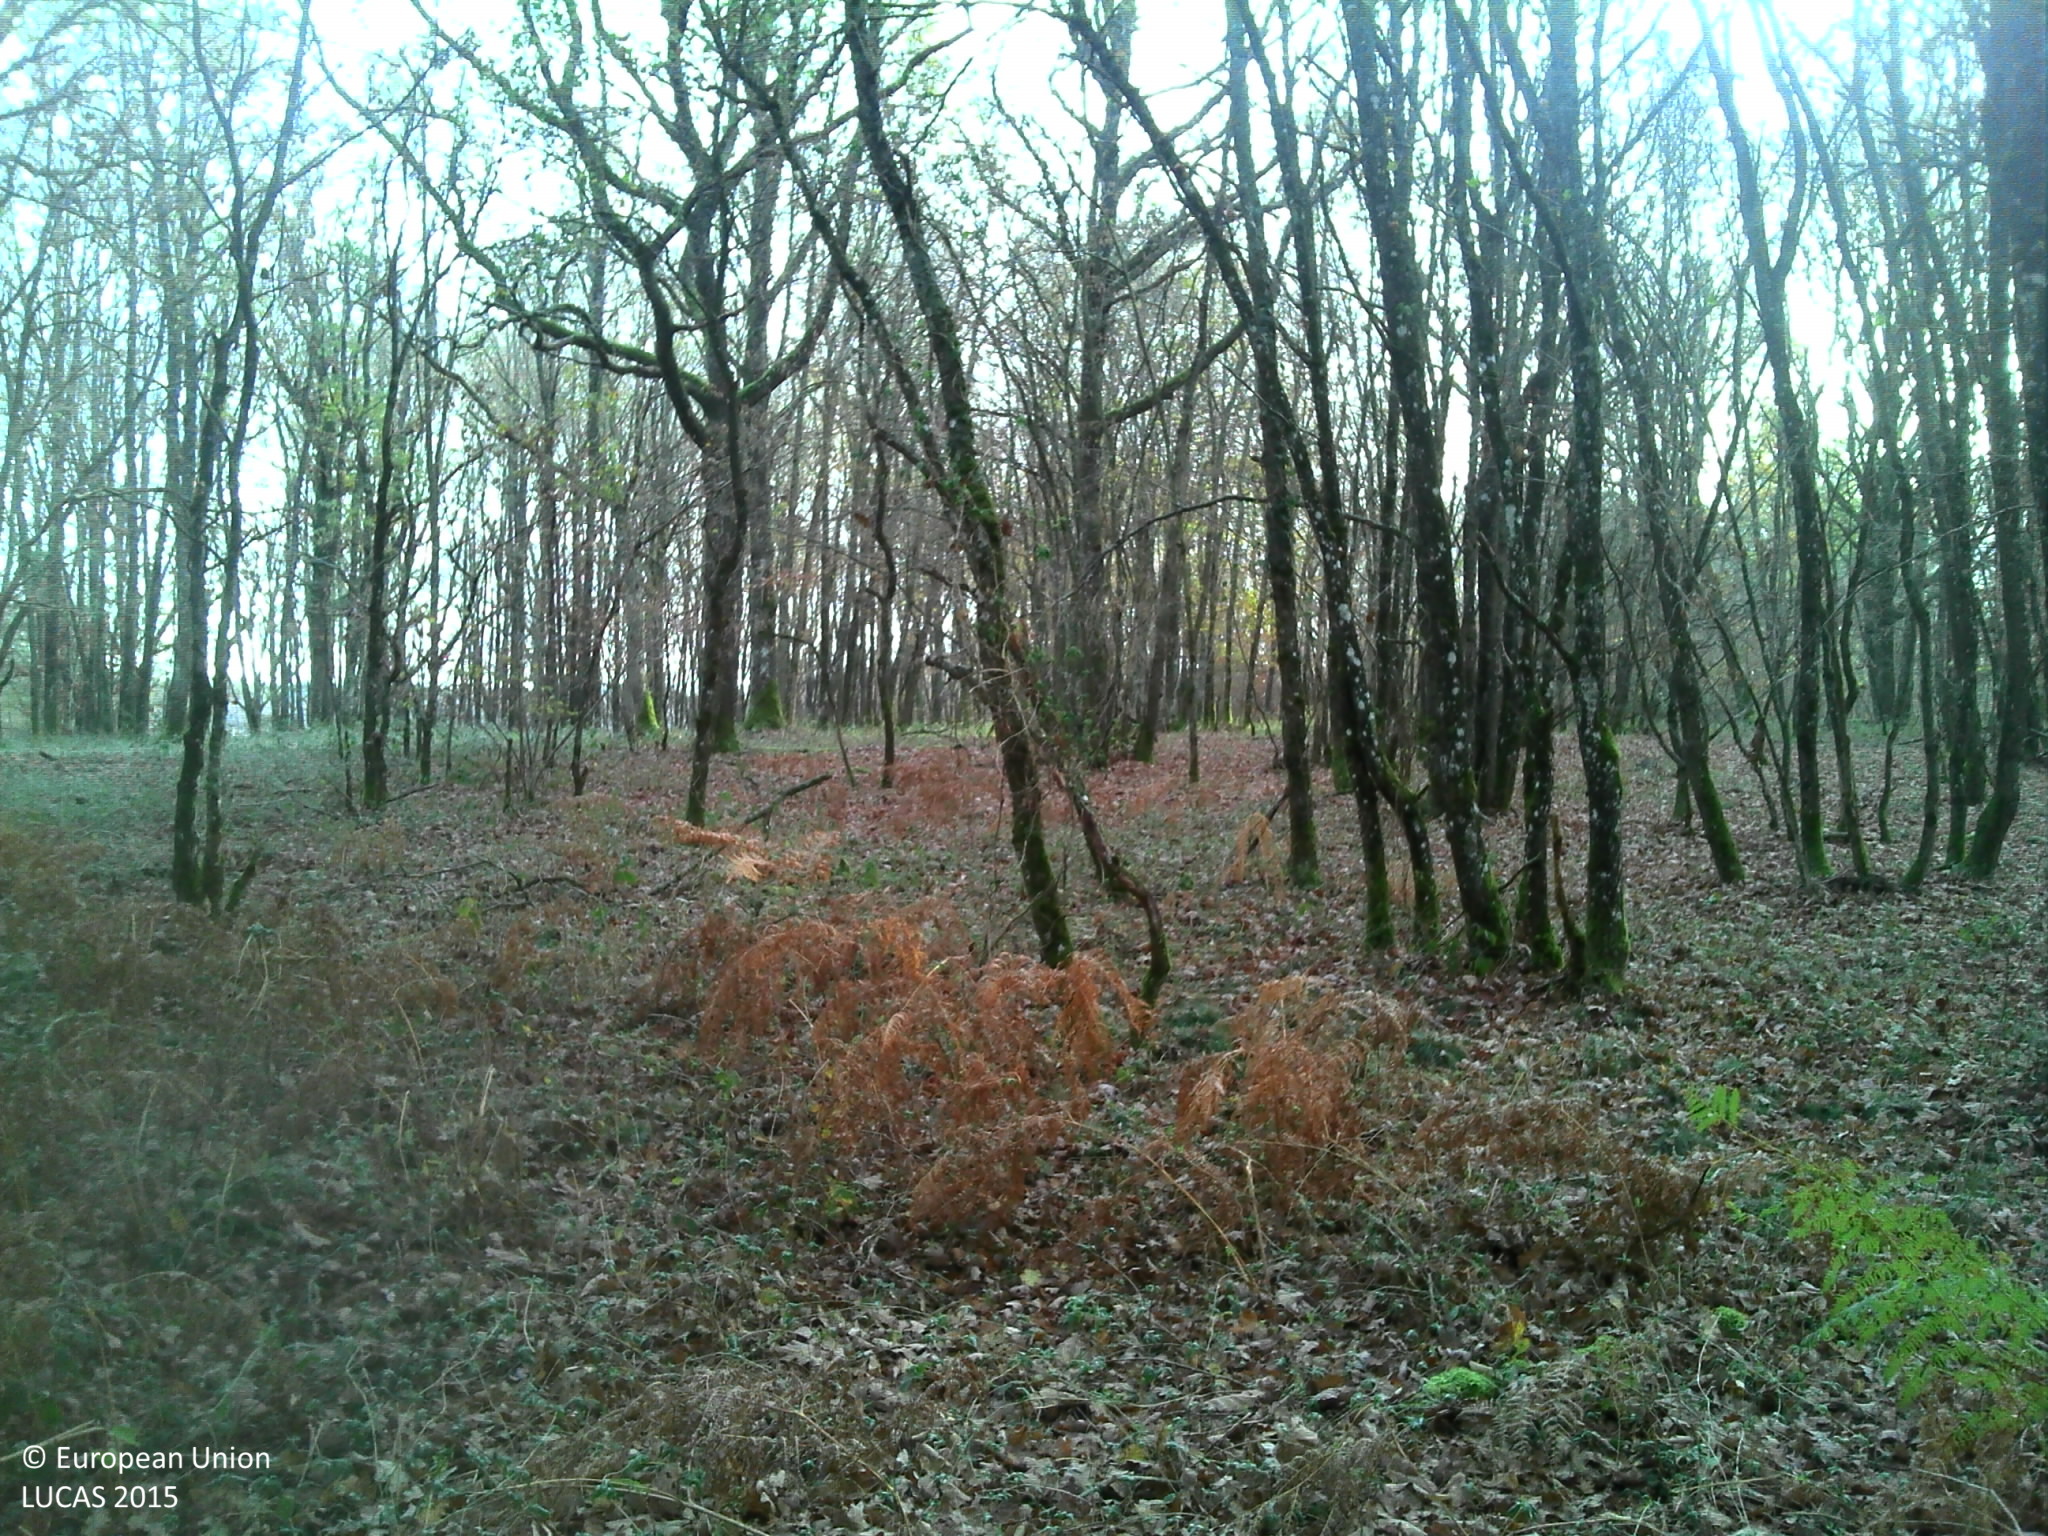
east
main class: Woodland
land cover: Broadleaved woodland
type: acidophilous oak and oak-birch forest
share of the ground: 50 - 75 %
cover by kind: broadleaved forest trees 70 %, unconsolidated bare surface 15 %, shrubs 5 %, herbaceous plants 5 %, lichens and mosses 5 %
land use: Forestry
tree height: > 5 m
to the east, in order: Broadleaved woodland; Tracks; Broadleaved woodland; Rivers and streams; Broadleaved woodland; Fences; Broadleaved woodland; Shrubland without tree cover; Grassland without tree/shrub cover
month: November
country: FR
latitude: 46.2189
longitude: 3.6869
